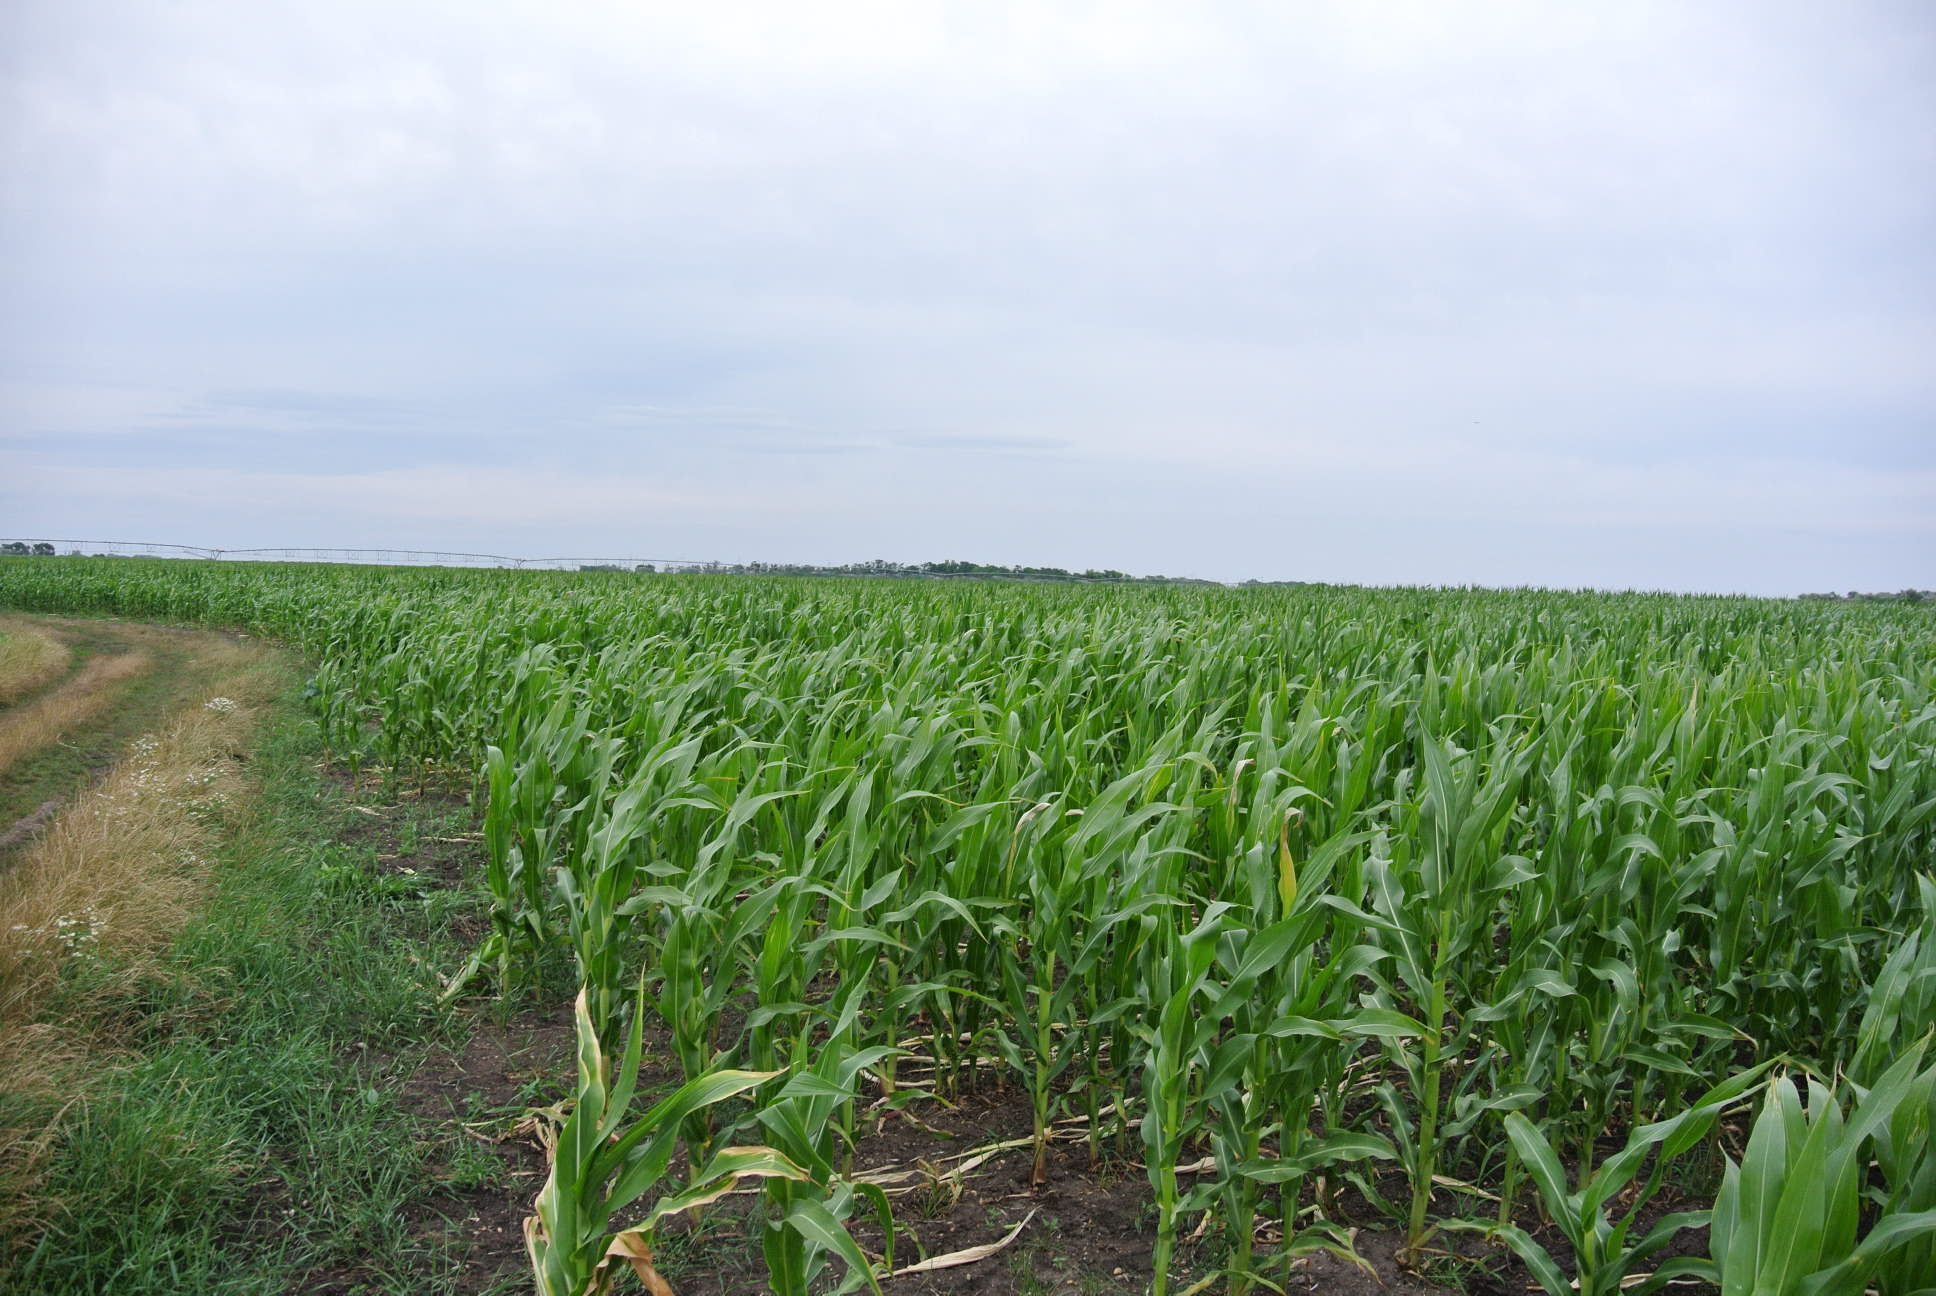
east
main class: Cropland
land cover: Maize
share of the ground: > 75 %
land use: Agriculture (excluding fallow land and kitchen gardens)
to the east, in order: Tracks; Grass margins; Maize
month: July
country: AT
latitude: 47.7918
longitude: 16.8808
